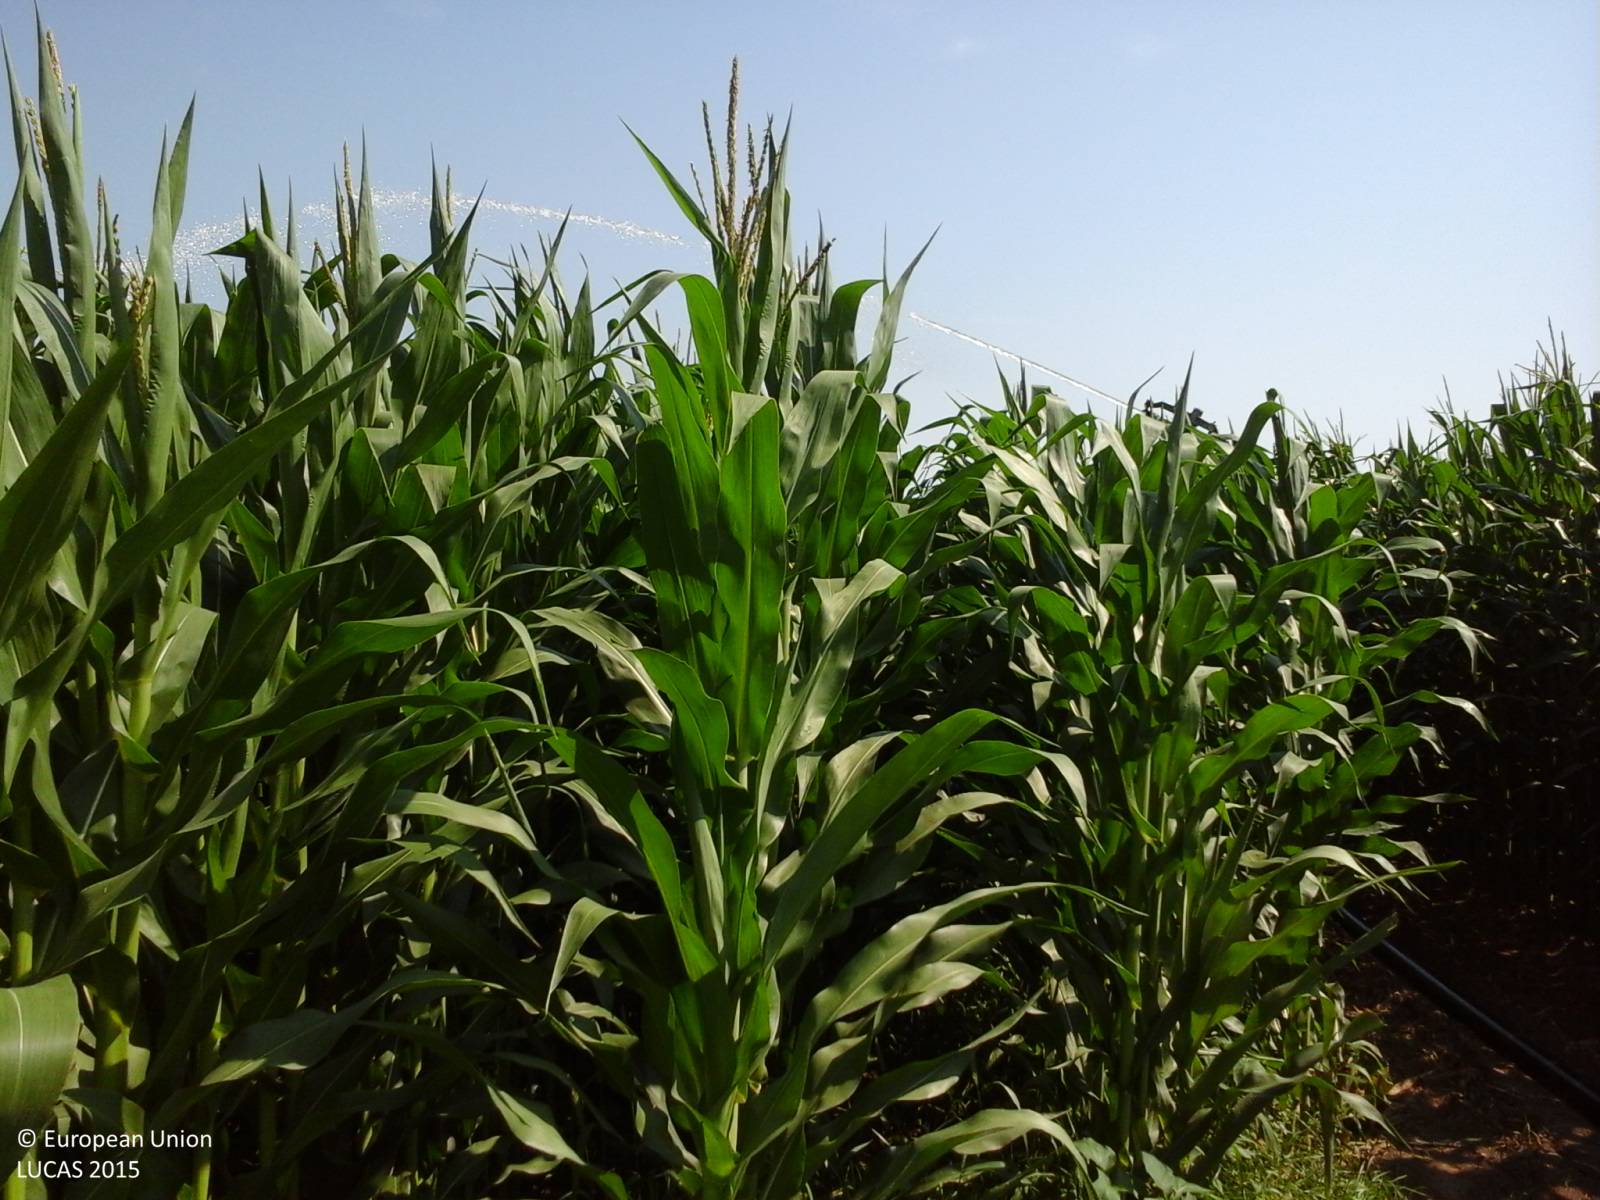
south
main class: Cropland
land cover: Maize
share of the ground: > 75 %
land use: Agriculture (excluding fallow land and kitchen gardens)
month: July
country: IT
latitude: 41.0125
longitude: 14.1567
